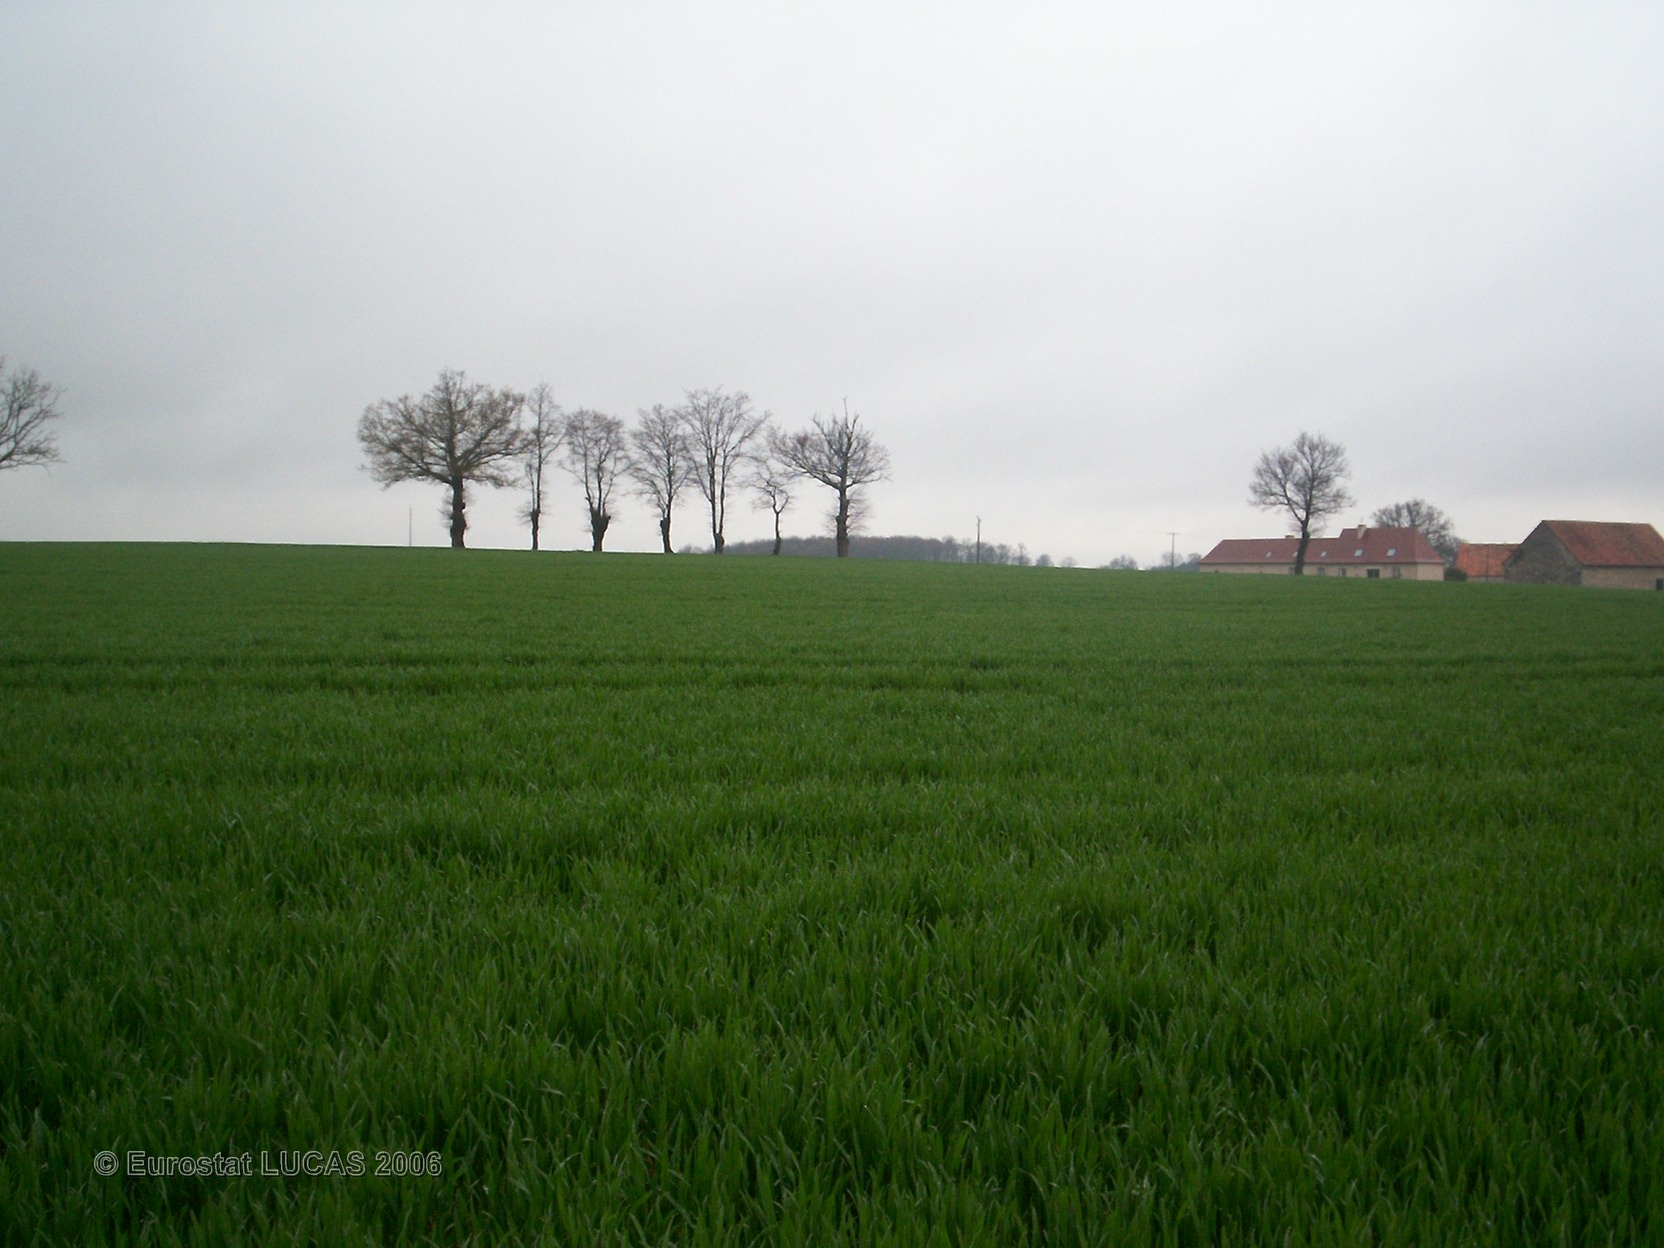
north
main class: Cropland
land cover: Common wheat
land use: Agriculture (excluding fallow land and kitchen gardens)
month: April
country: FR
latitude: 46.3923
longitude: 1.0530
